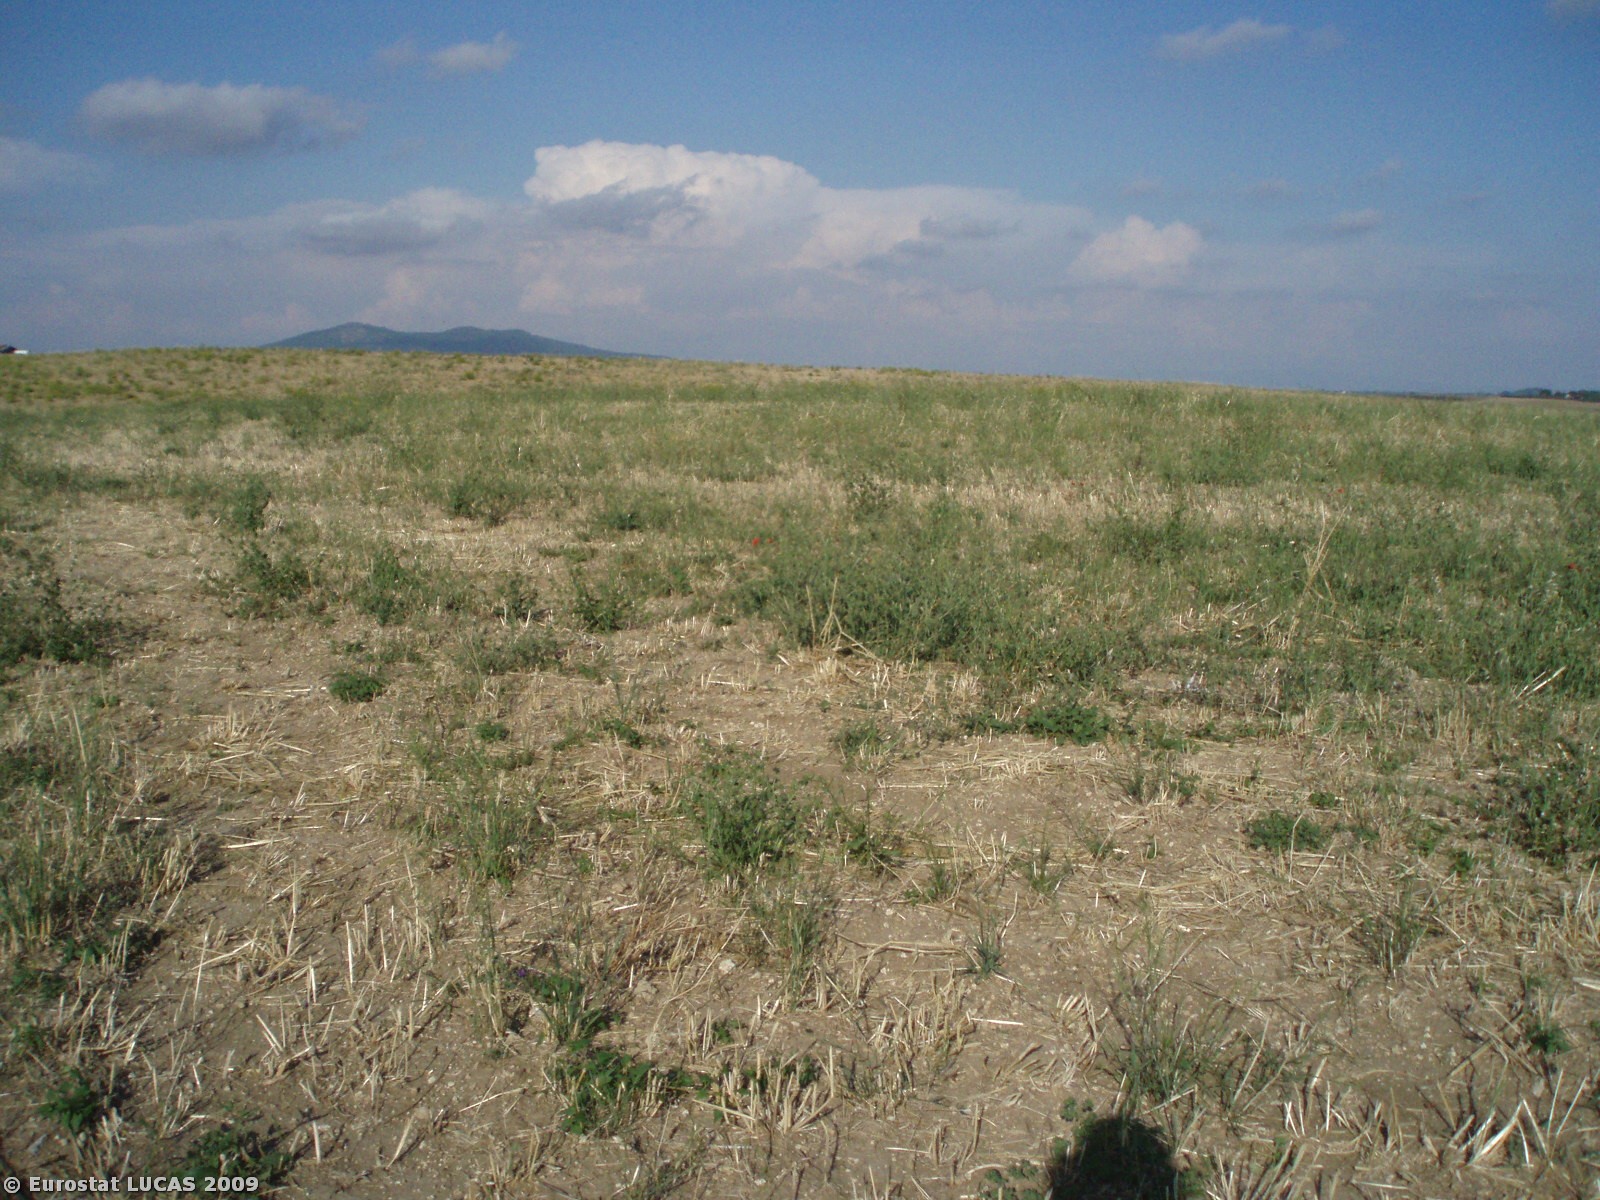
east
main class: Cropland
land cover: Temporary grasslands
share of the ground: > 75 %
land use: Agriculture (excluding fallow land and kitchen gardens)
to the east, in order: Temporary grasslands
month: June
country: IT
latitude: 42.4429
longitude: 11.5871
